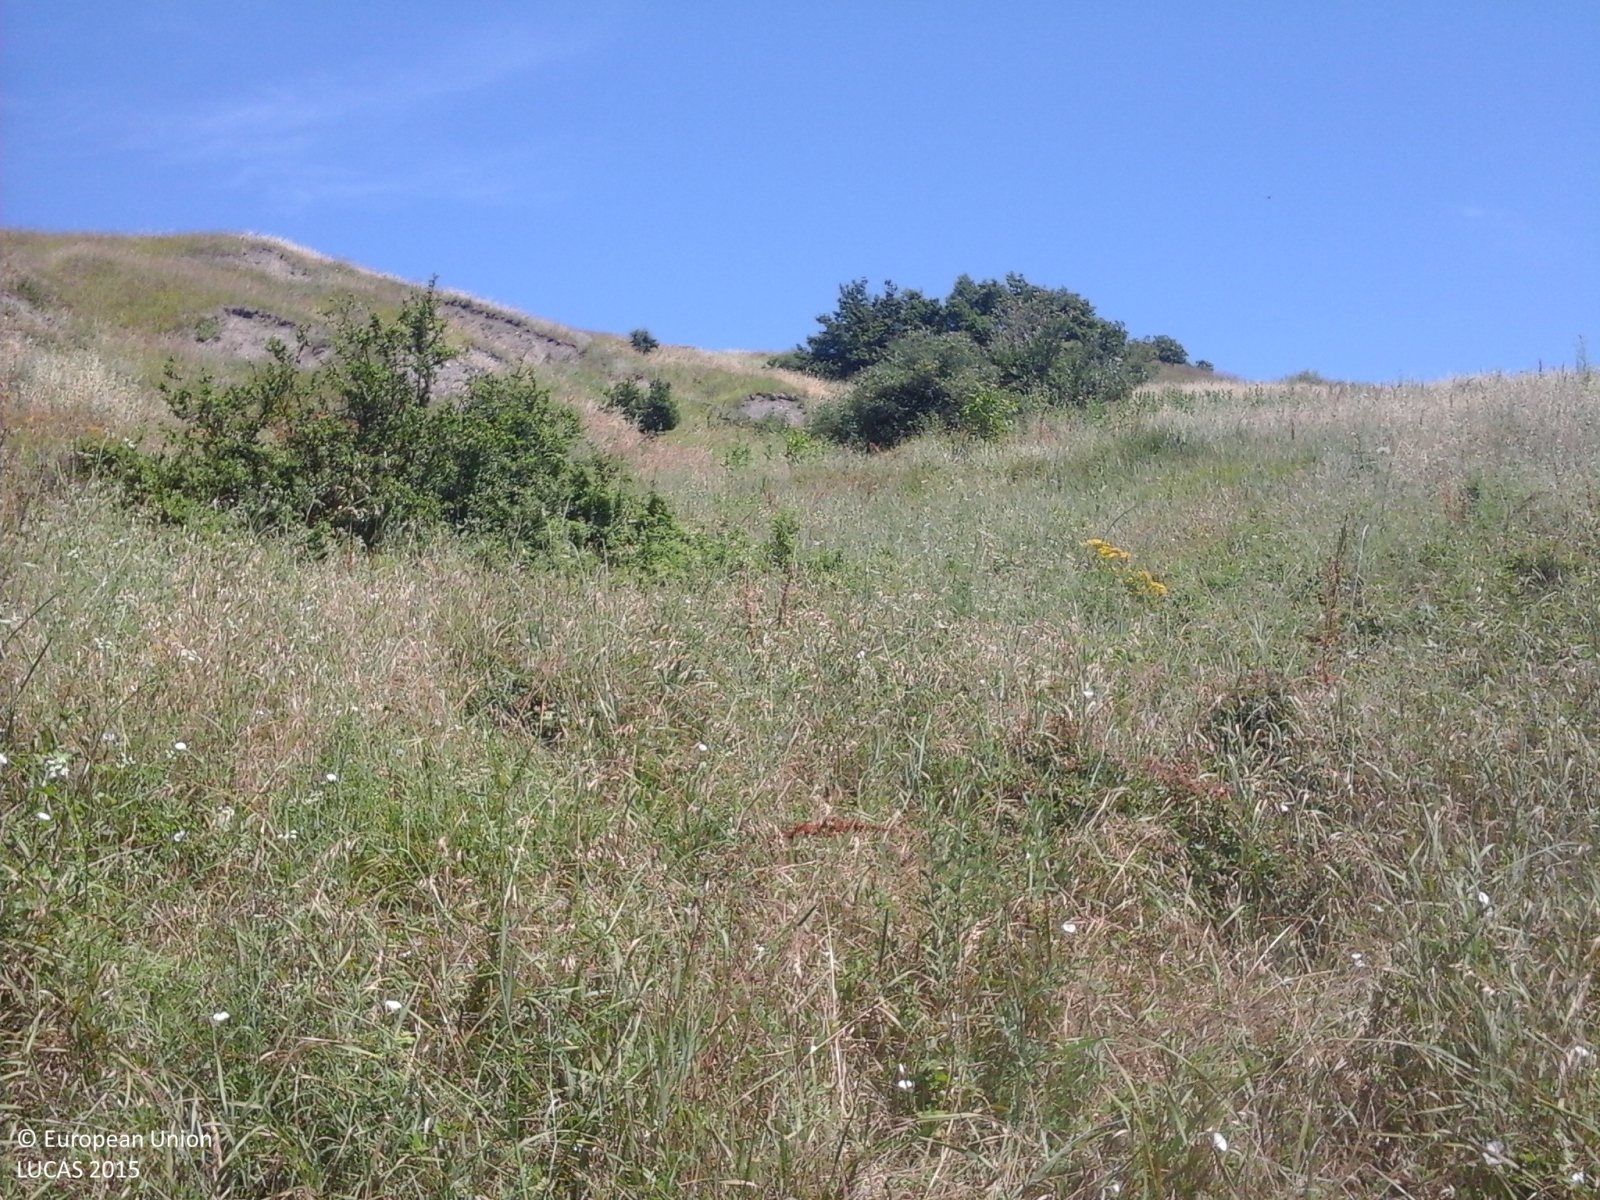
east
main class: Grassland
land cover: Grassland with sparse tree/shrub cover
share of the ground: > 75 %
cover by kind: herbaceous plants 90 %, broadleaved forest trees 5 %, shrubs 5 %
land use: Semi-natural and natural areas not in use
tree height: > 5 m
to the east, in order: Grassland with sparse tree/shrub cover; Rocks and stones; Grassland without tree/shrub cover; Rocks and stones; Grassland with sparse tree/shrub cover
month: June
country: IT
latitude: 44.4929
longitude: 10.6399
